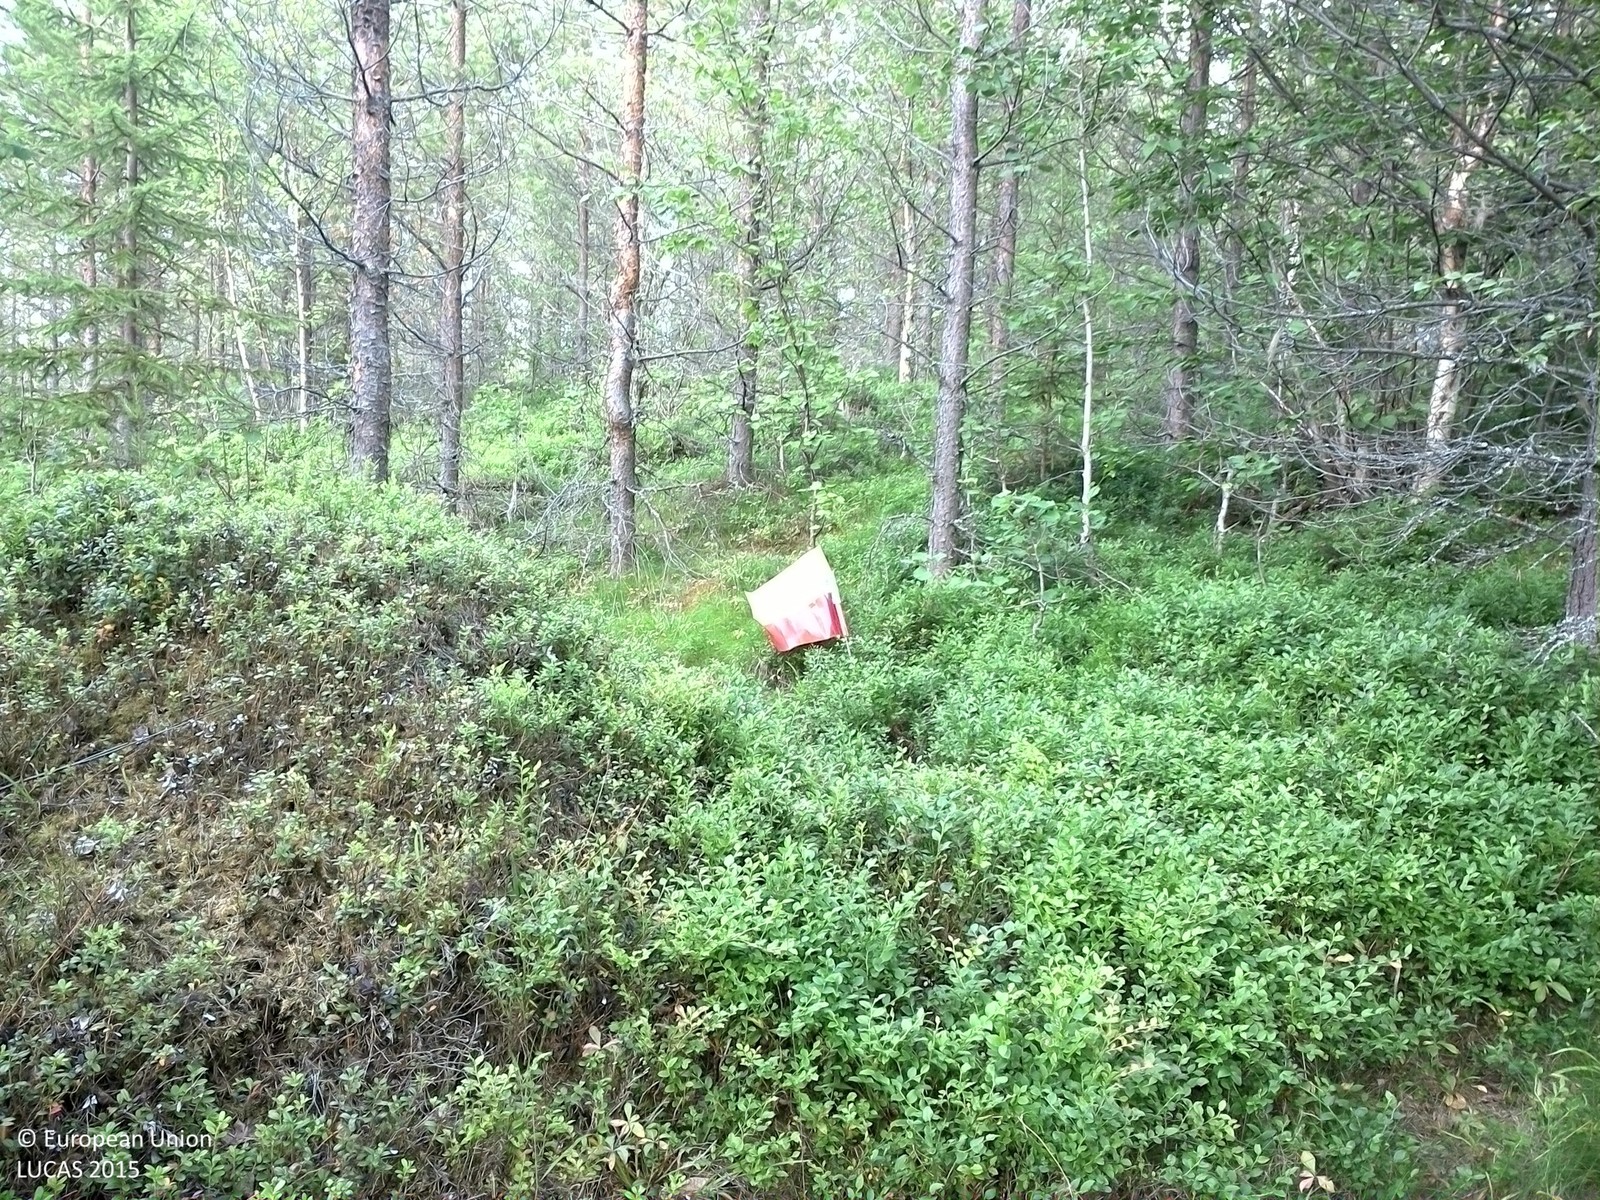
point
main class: Woodland
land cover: Pine dominated mixed woodland
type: boreal forest
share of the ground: 50 - 75 %
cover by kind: coniferous forest trees 45 %, shrubs 25 %, broadleaved forest trees 15 %, lichens and mosses 10 %, herbaceous plants 5 %
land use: Forestry
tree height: > 5 m
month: August
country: SE
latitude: 63.7405
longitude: 16.4753
